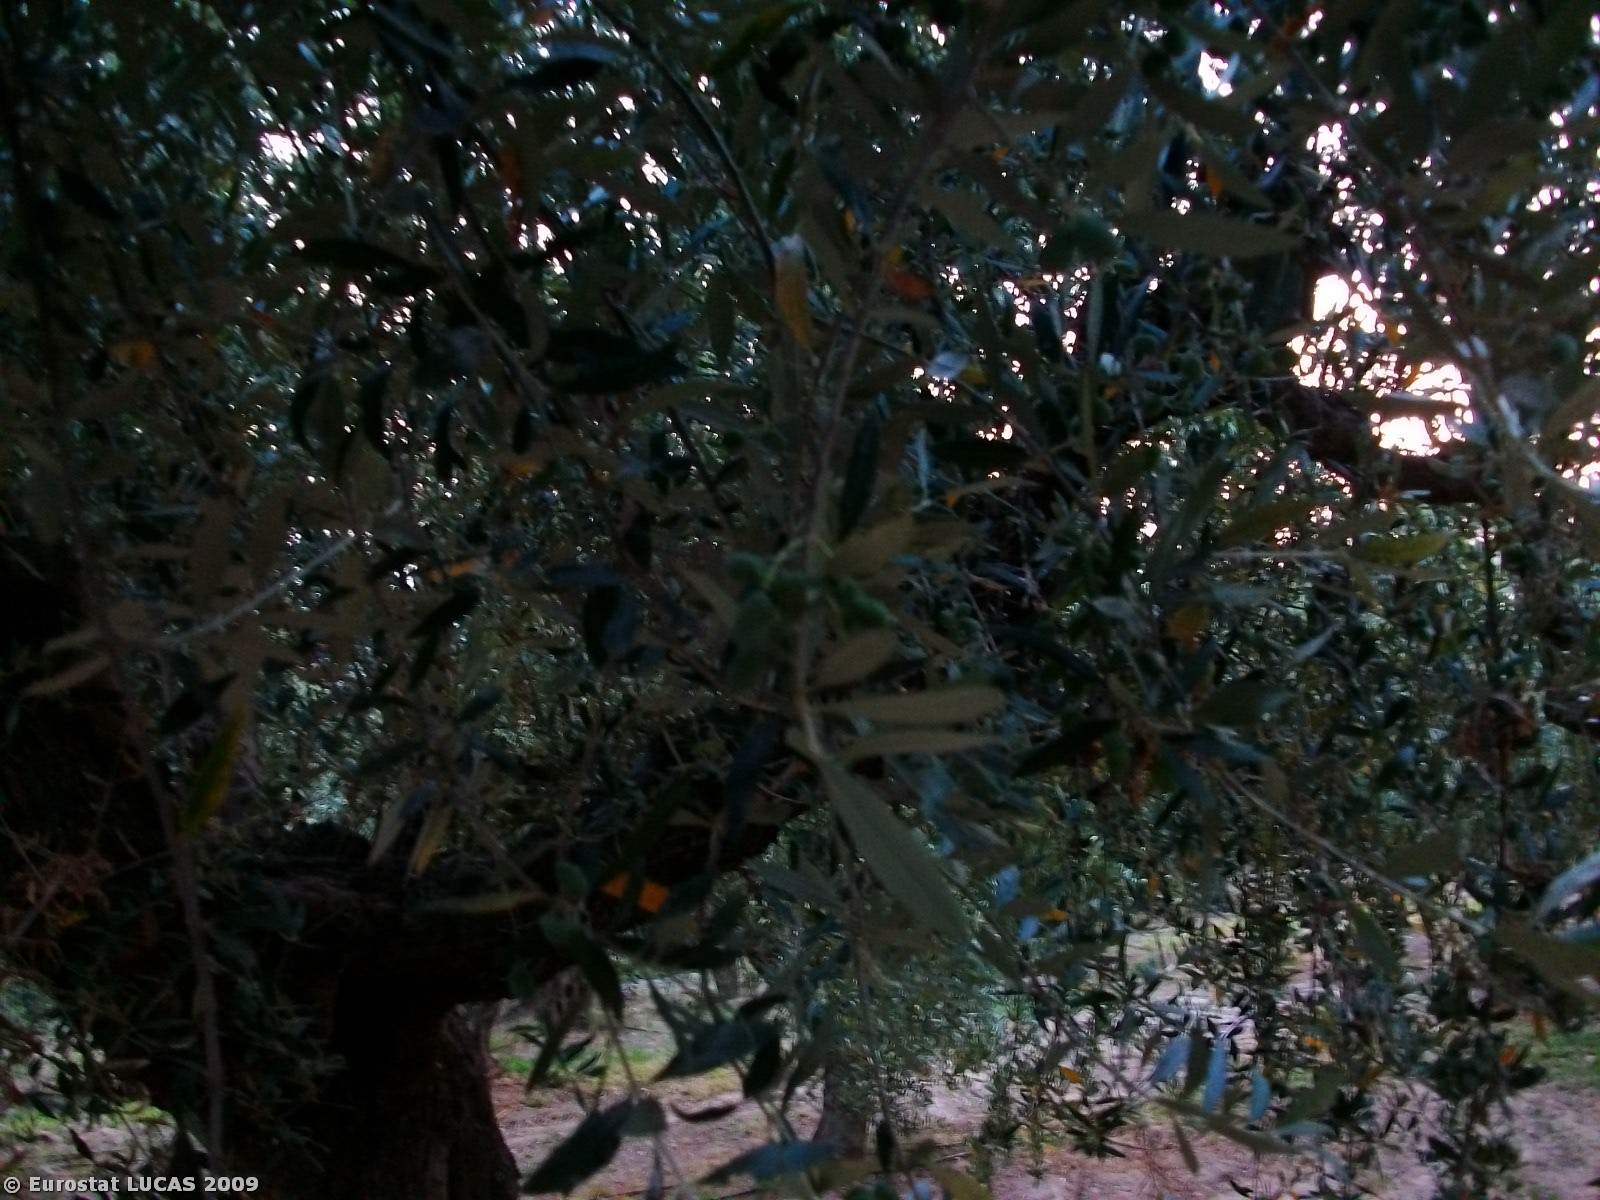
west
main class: Cropland
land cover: Olive groves
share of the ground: 25 - 50 %
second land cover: Bare land
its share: > 75 %
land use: Agriculture (excluding fallow land and kitchen gardens)
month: August
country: GR
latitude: 36.8696
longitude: 22.7321
